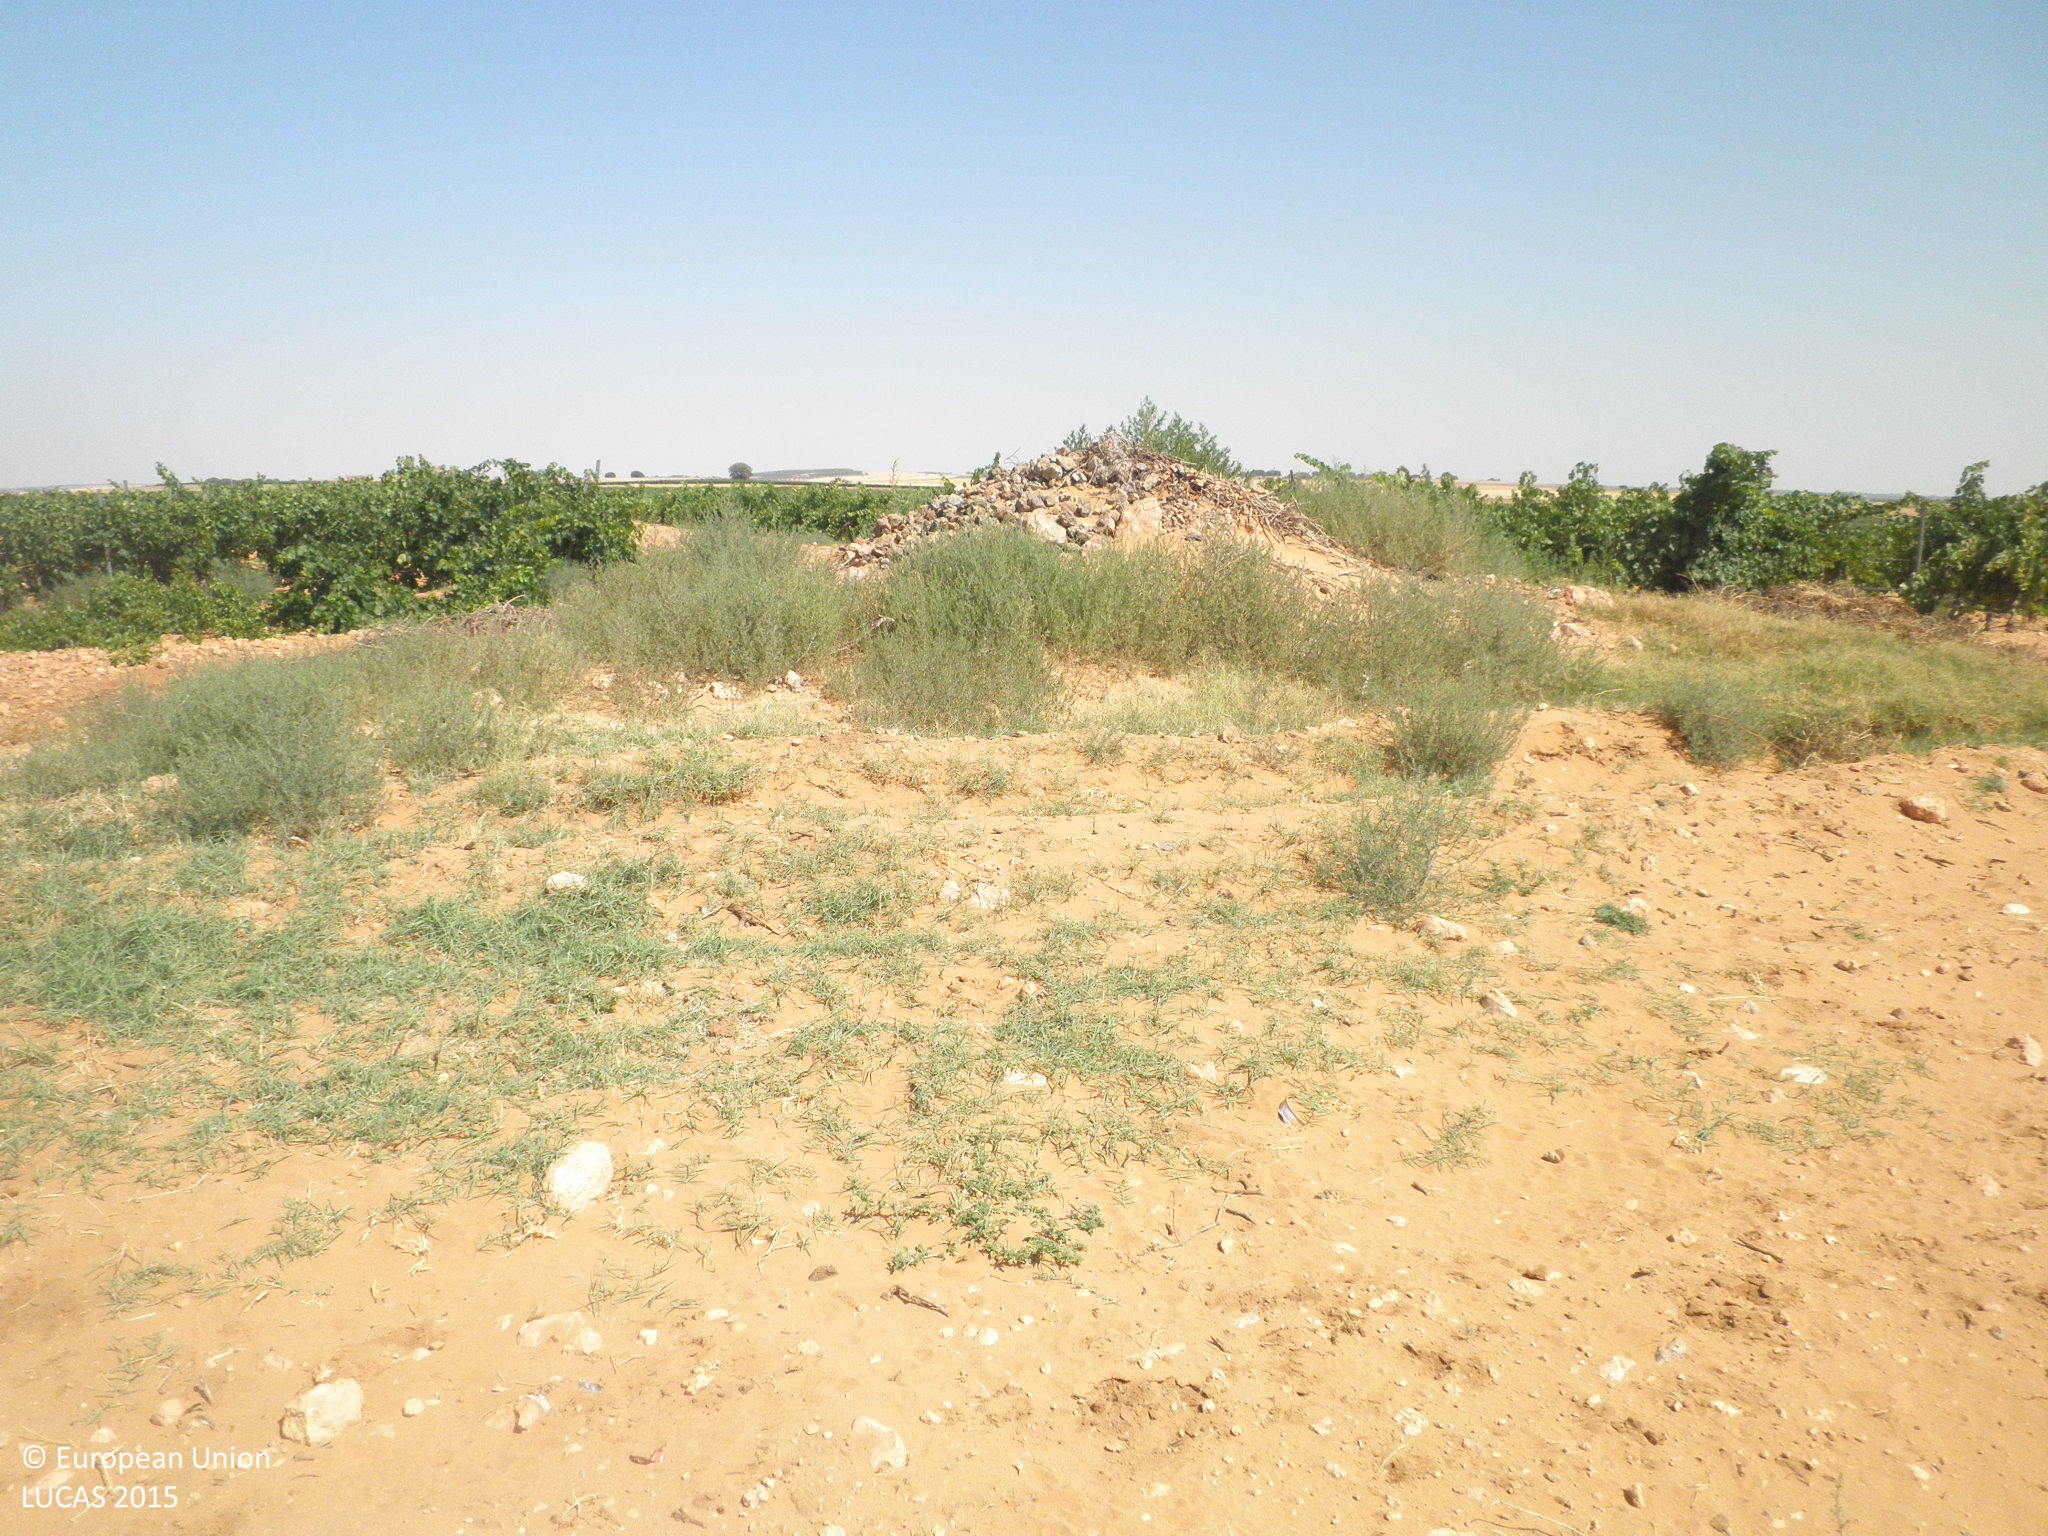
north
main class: Grassland
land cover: Spontaneously vegetated surfaces
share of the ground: 10 - 25 %
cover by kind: unconsolidated bare surface 90 %, herbaceous plants 10 %
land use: Fallow land
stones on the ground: 10 - 25 %
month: July
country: ES
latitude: 39.4339
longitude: -2.5944
